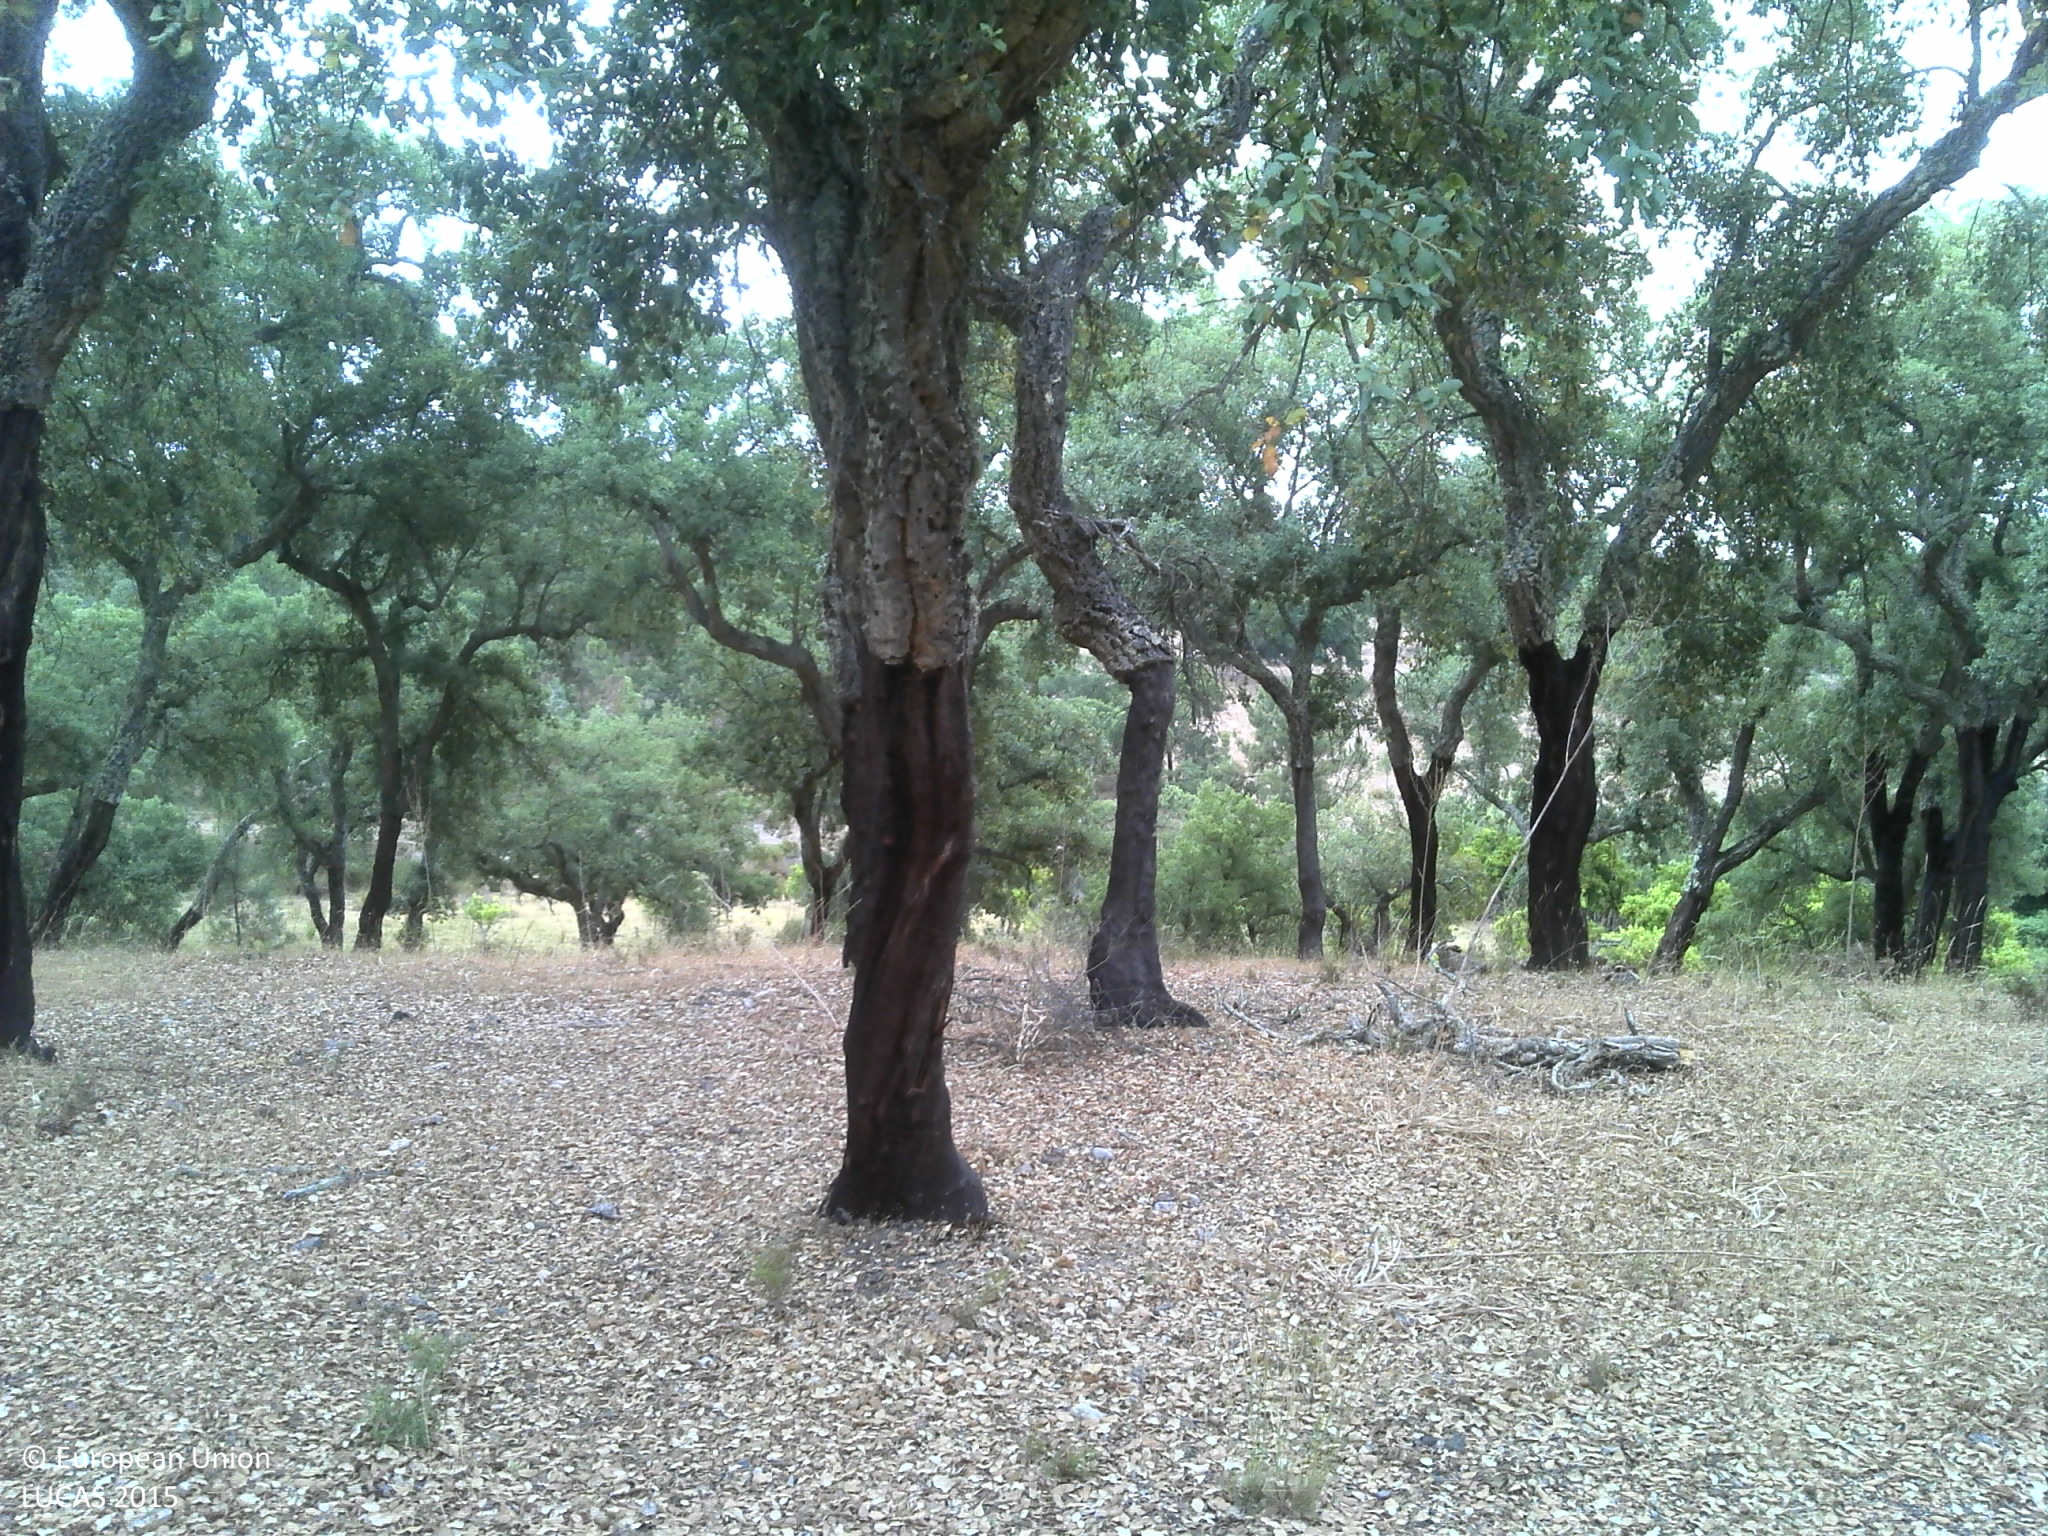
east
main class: Woodland
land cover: Broadleaved woodland
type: broadleaved evergreen forest
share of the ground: 25 - 50 %
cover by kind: broadleaved forest trees 50 %, unconsolidated bare surface 35 %, shrubs 10 %, herbaceous plants 5 %
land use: Forestry
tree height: > 5 m
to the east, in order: Broadleaved woodland; Tracks; Shruby margins; Oranges; Rivers and streams; Broadleaved woodland; Other bare soil; Broadleaved woodland; Tracks; Broadleaved woodland
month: June
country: PT
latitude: 39.3218
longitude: -8.0240
